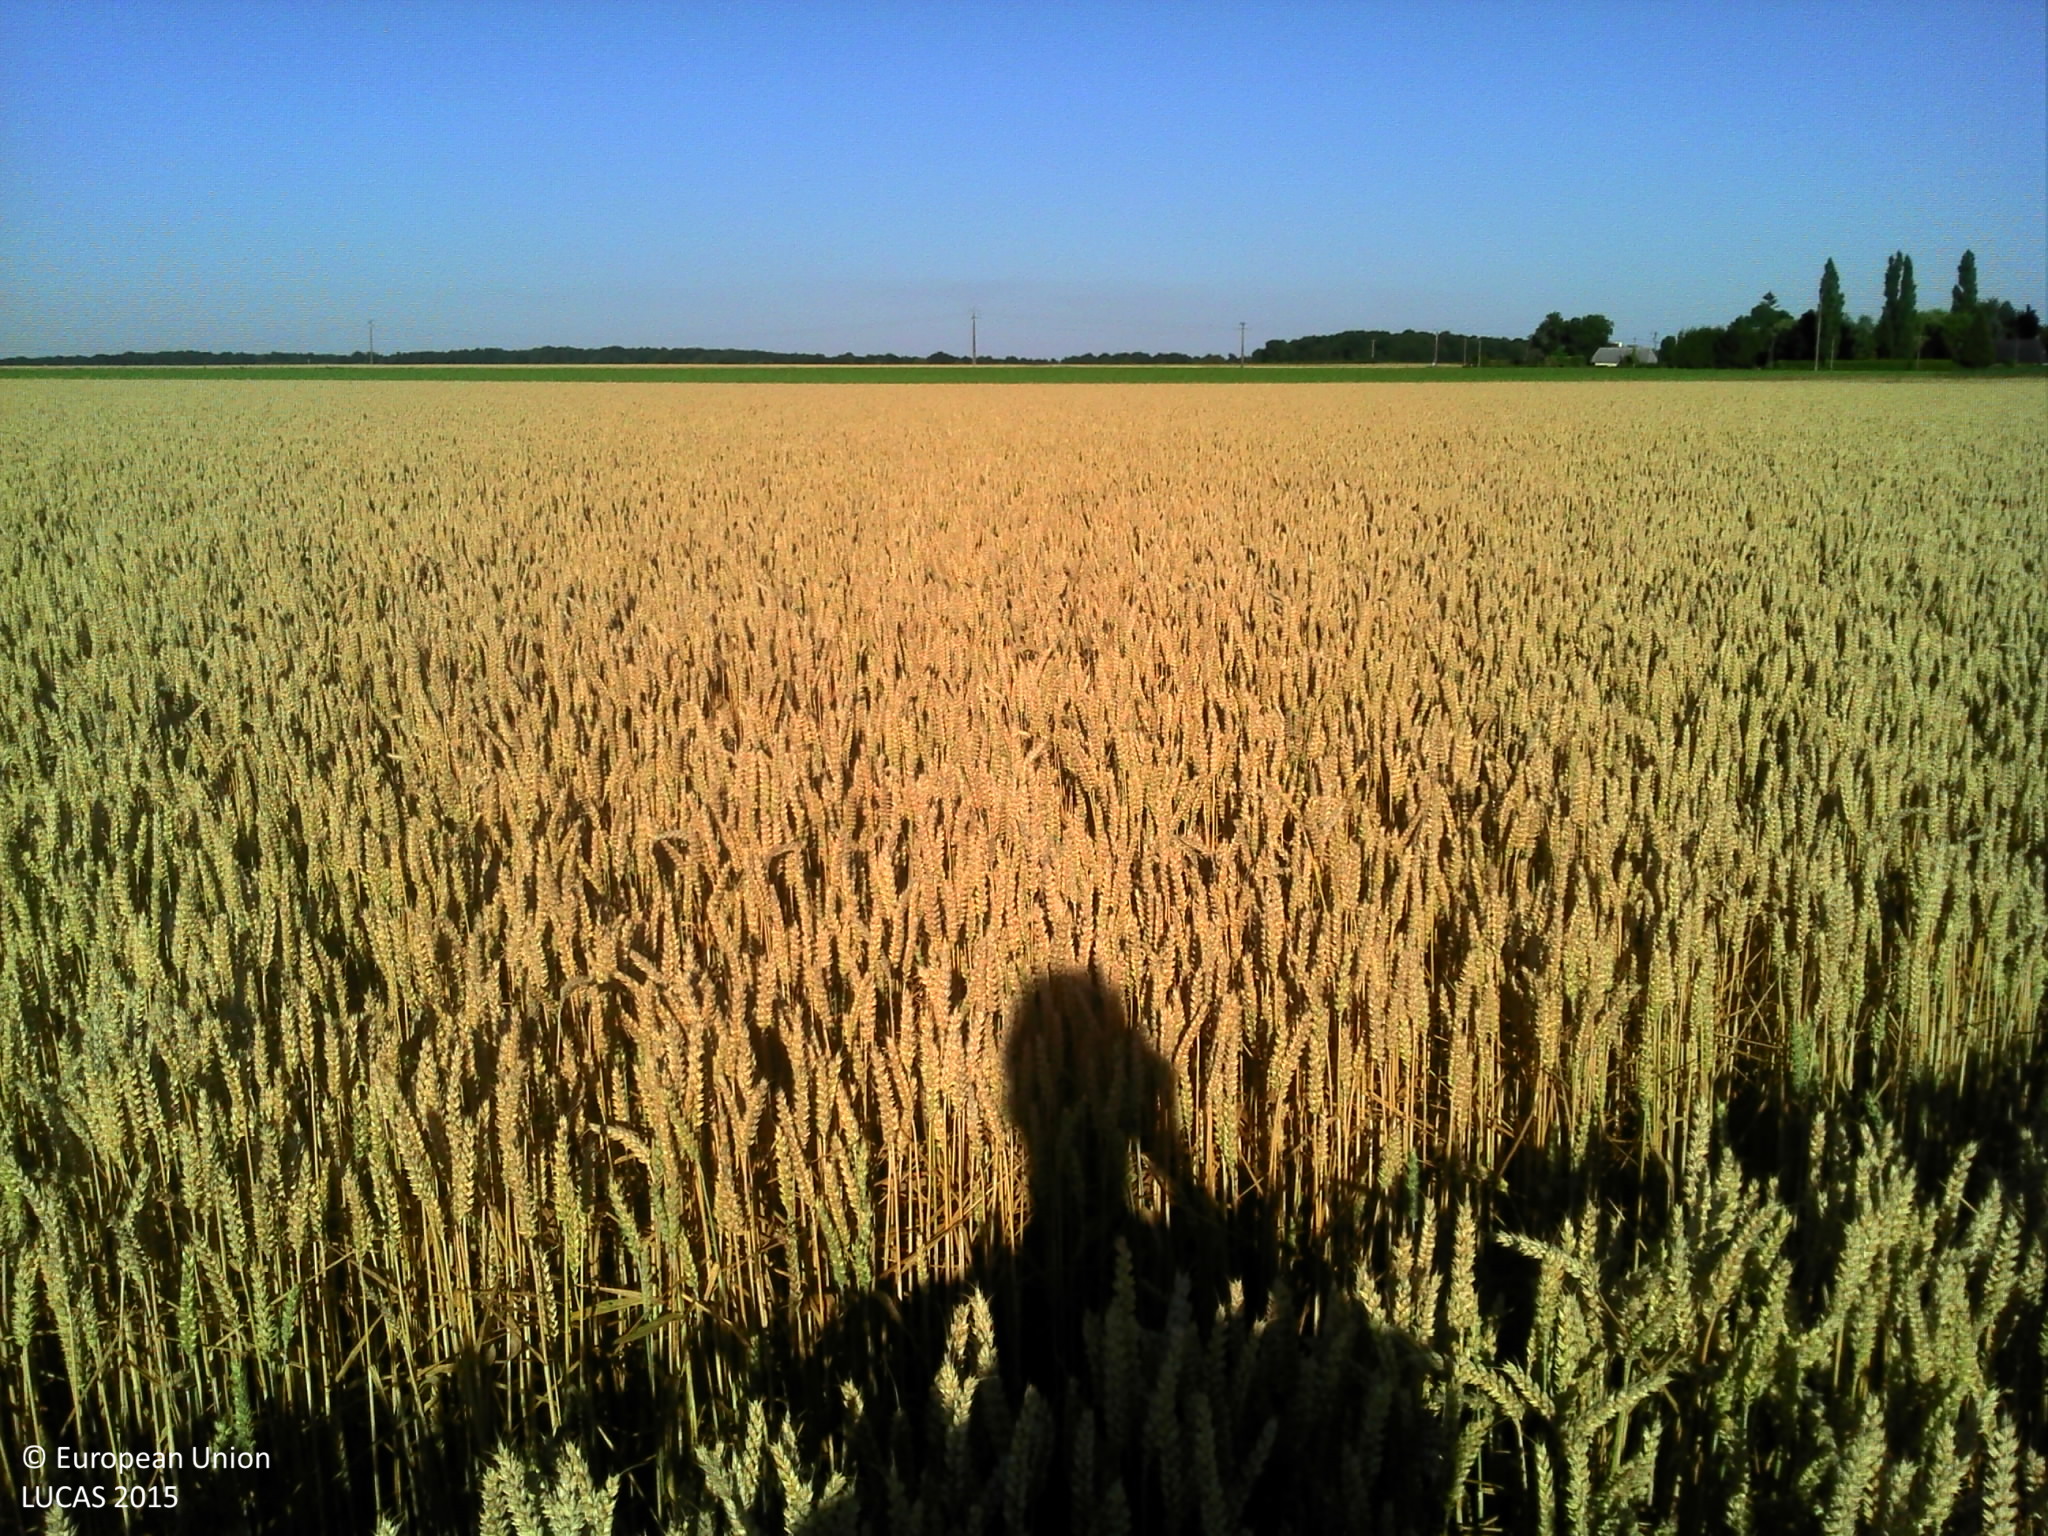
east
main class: Cropland
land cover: Common wheat
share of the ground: > 75 %
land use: Agriculture (excluding fallow land and kitchen gardens)
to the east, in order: Common wheat; Sugar beet
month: July
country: FR
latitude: 49.1132
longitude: 0.6731
